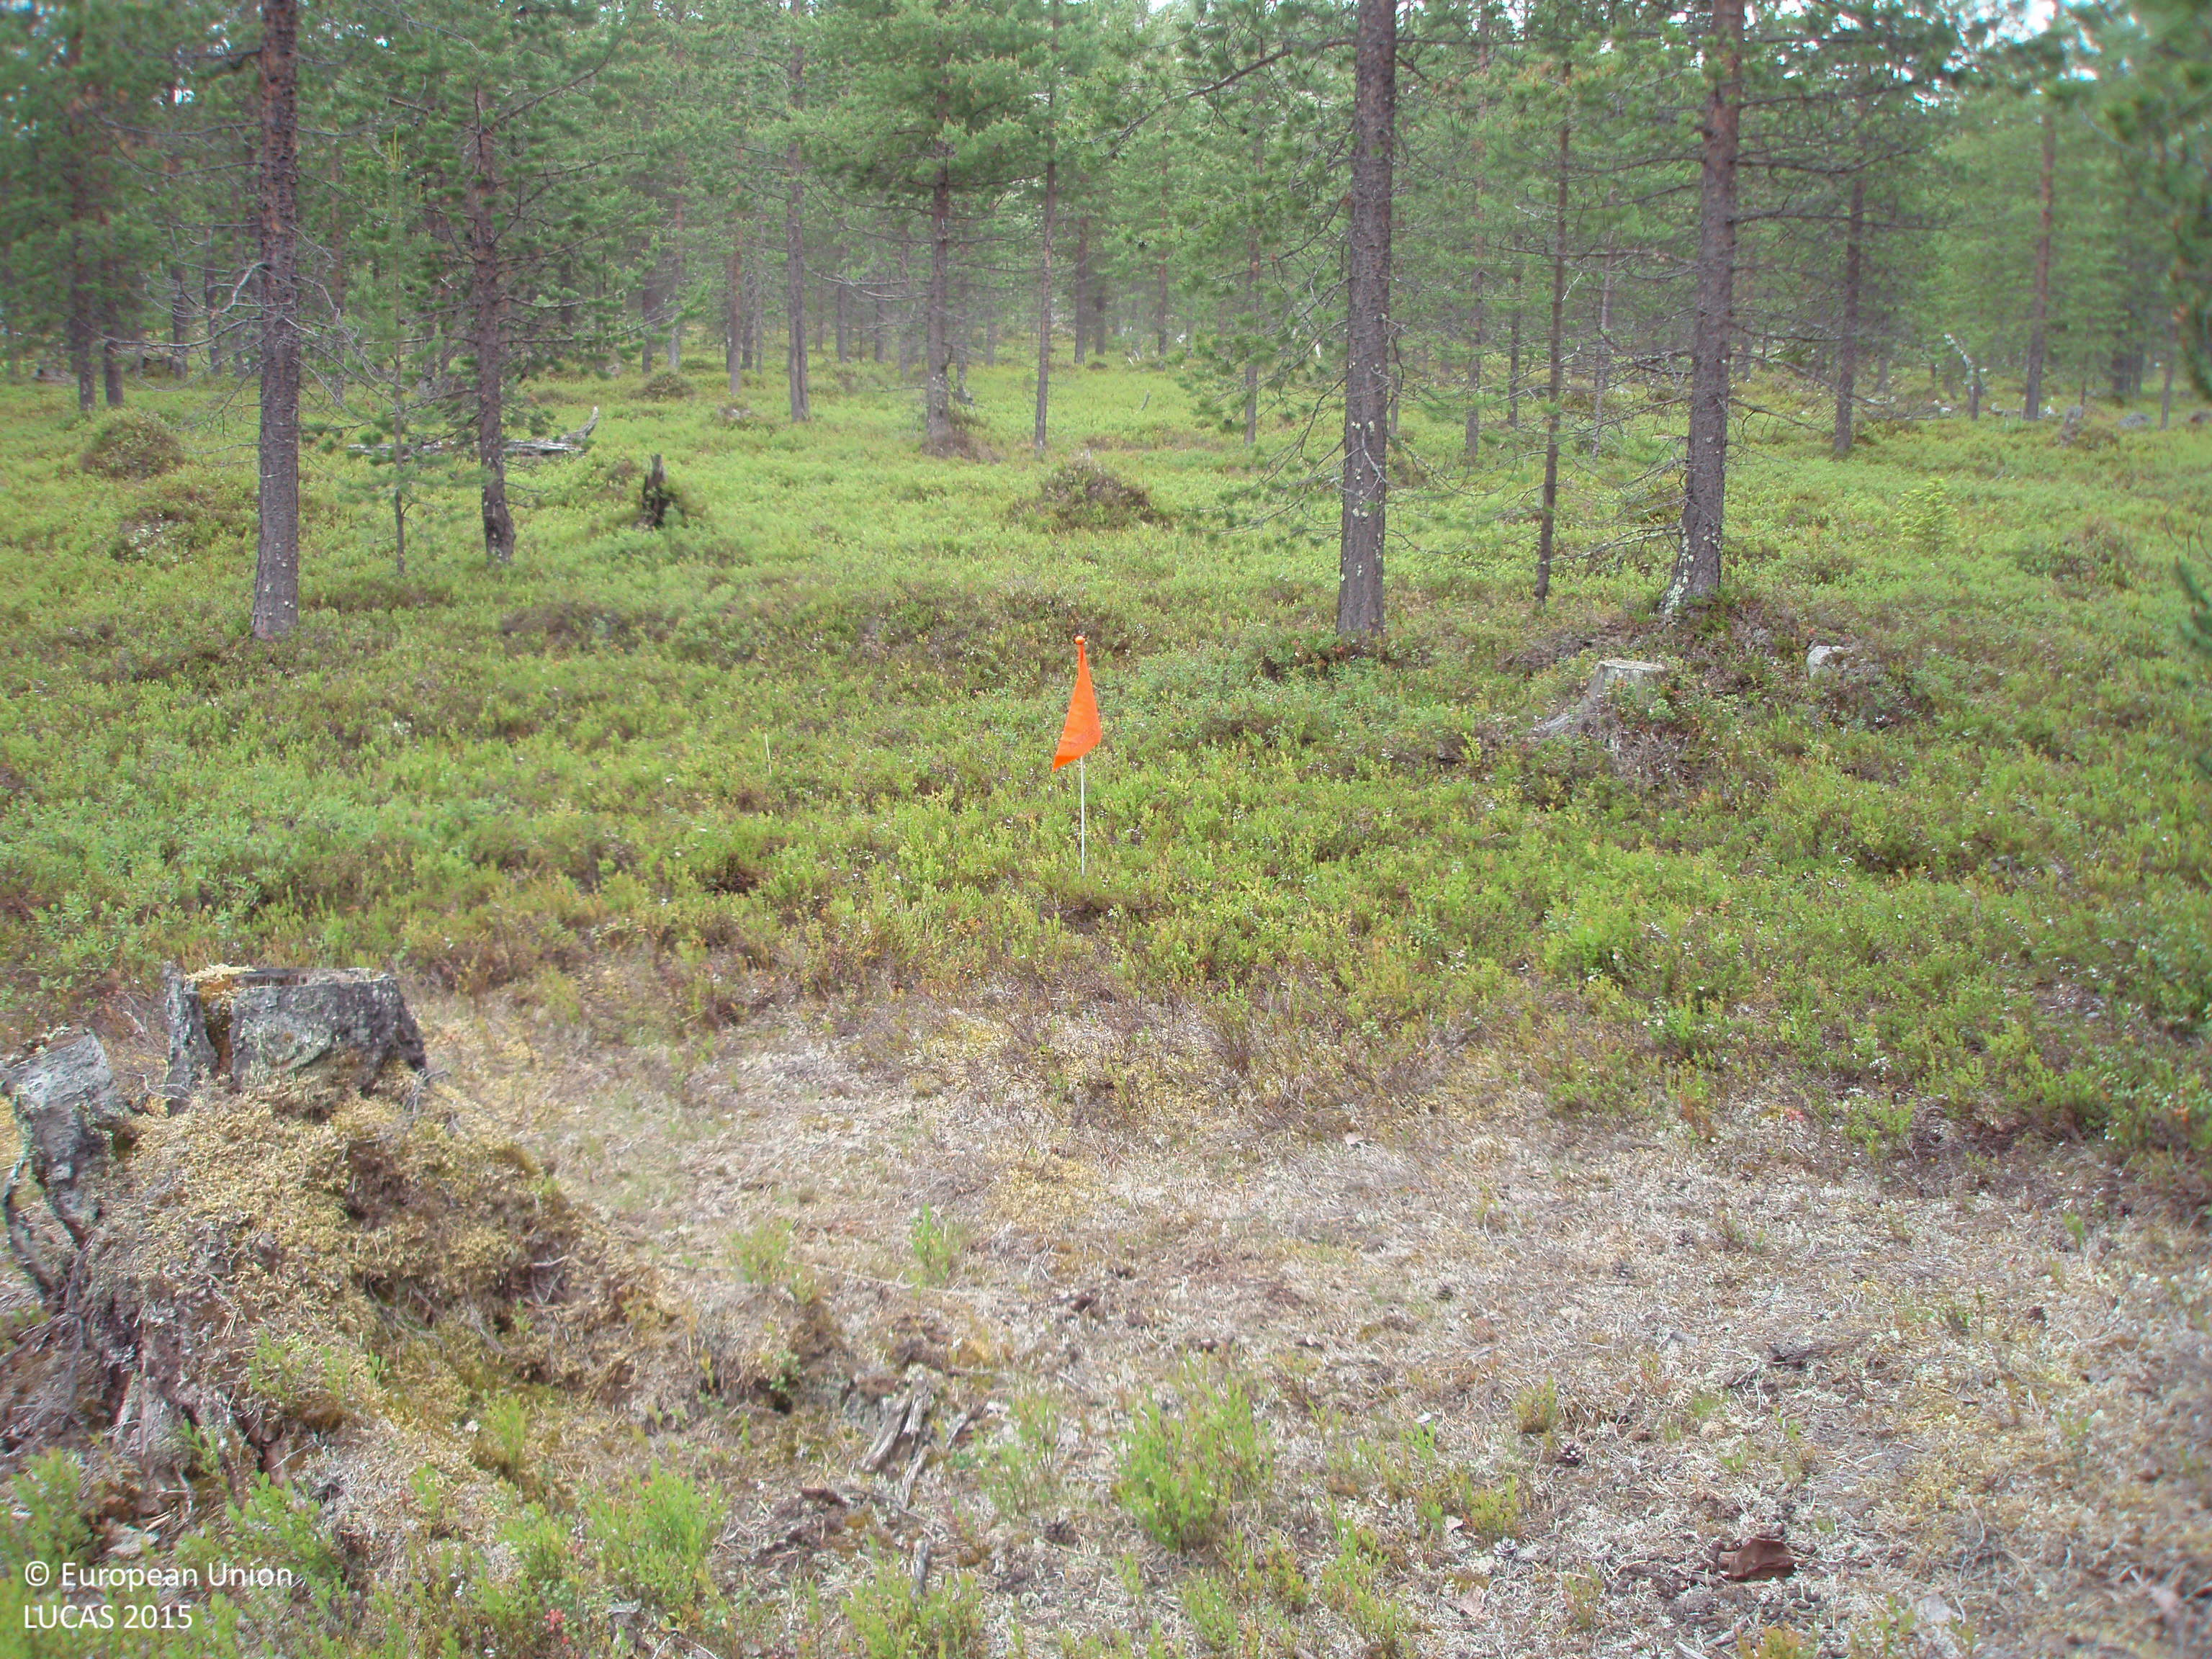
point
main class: Woodland
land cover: Pine dominated coniferous woodland
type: boreal forest
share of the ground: 50 - 75 %
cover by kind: coniferous forest trees 50 %, shrubs 50 %
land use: Forestry
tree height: > 5 m
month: July
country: FI
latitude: 67.7229
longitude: 28.9316
